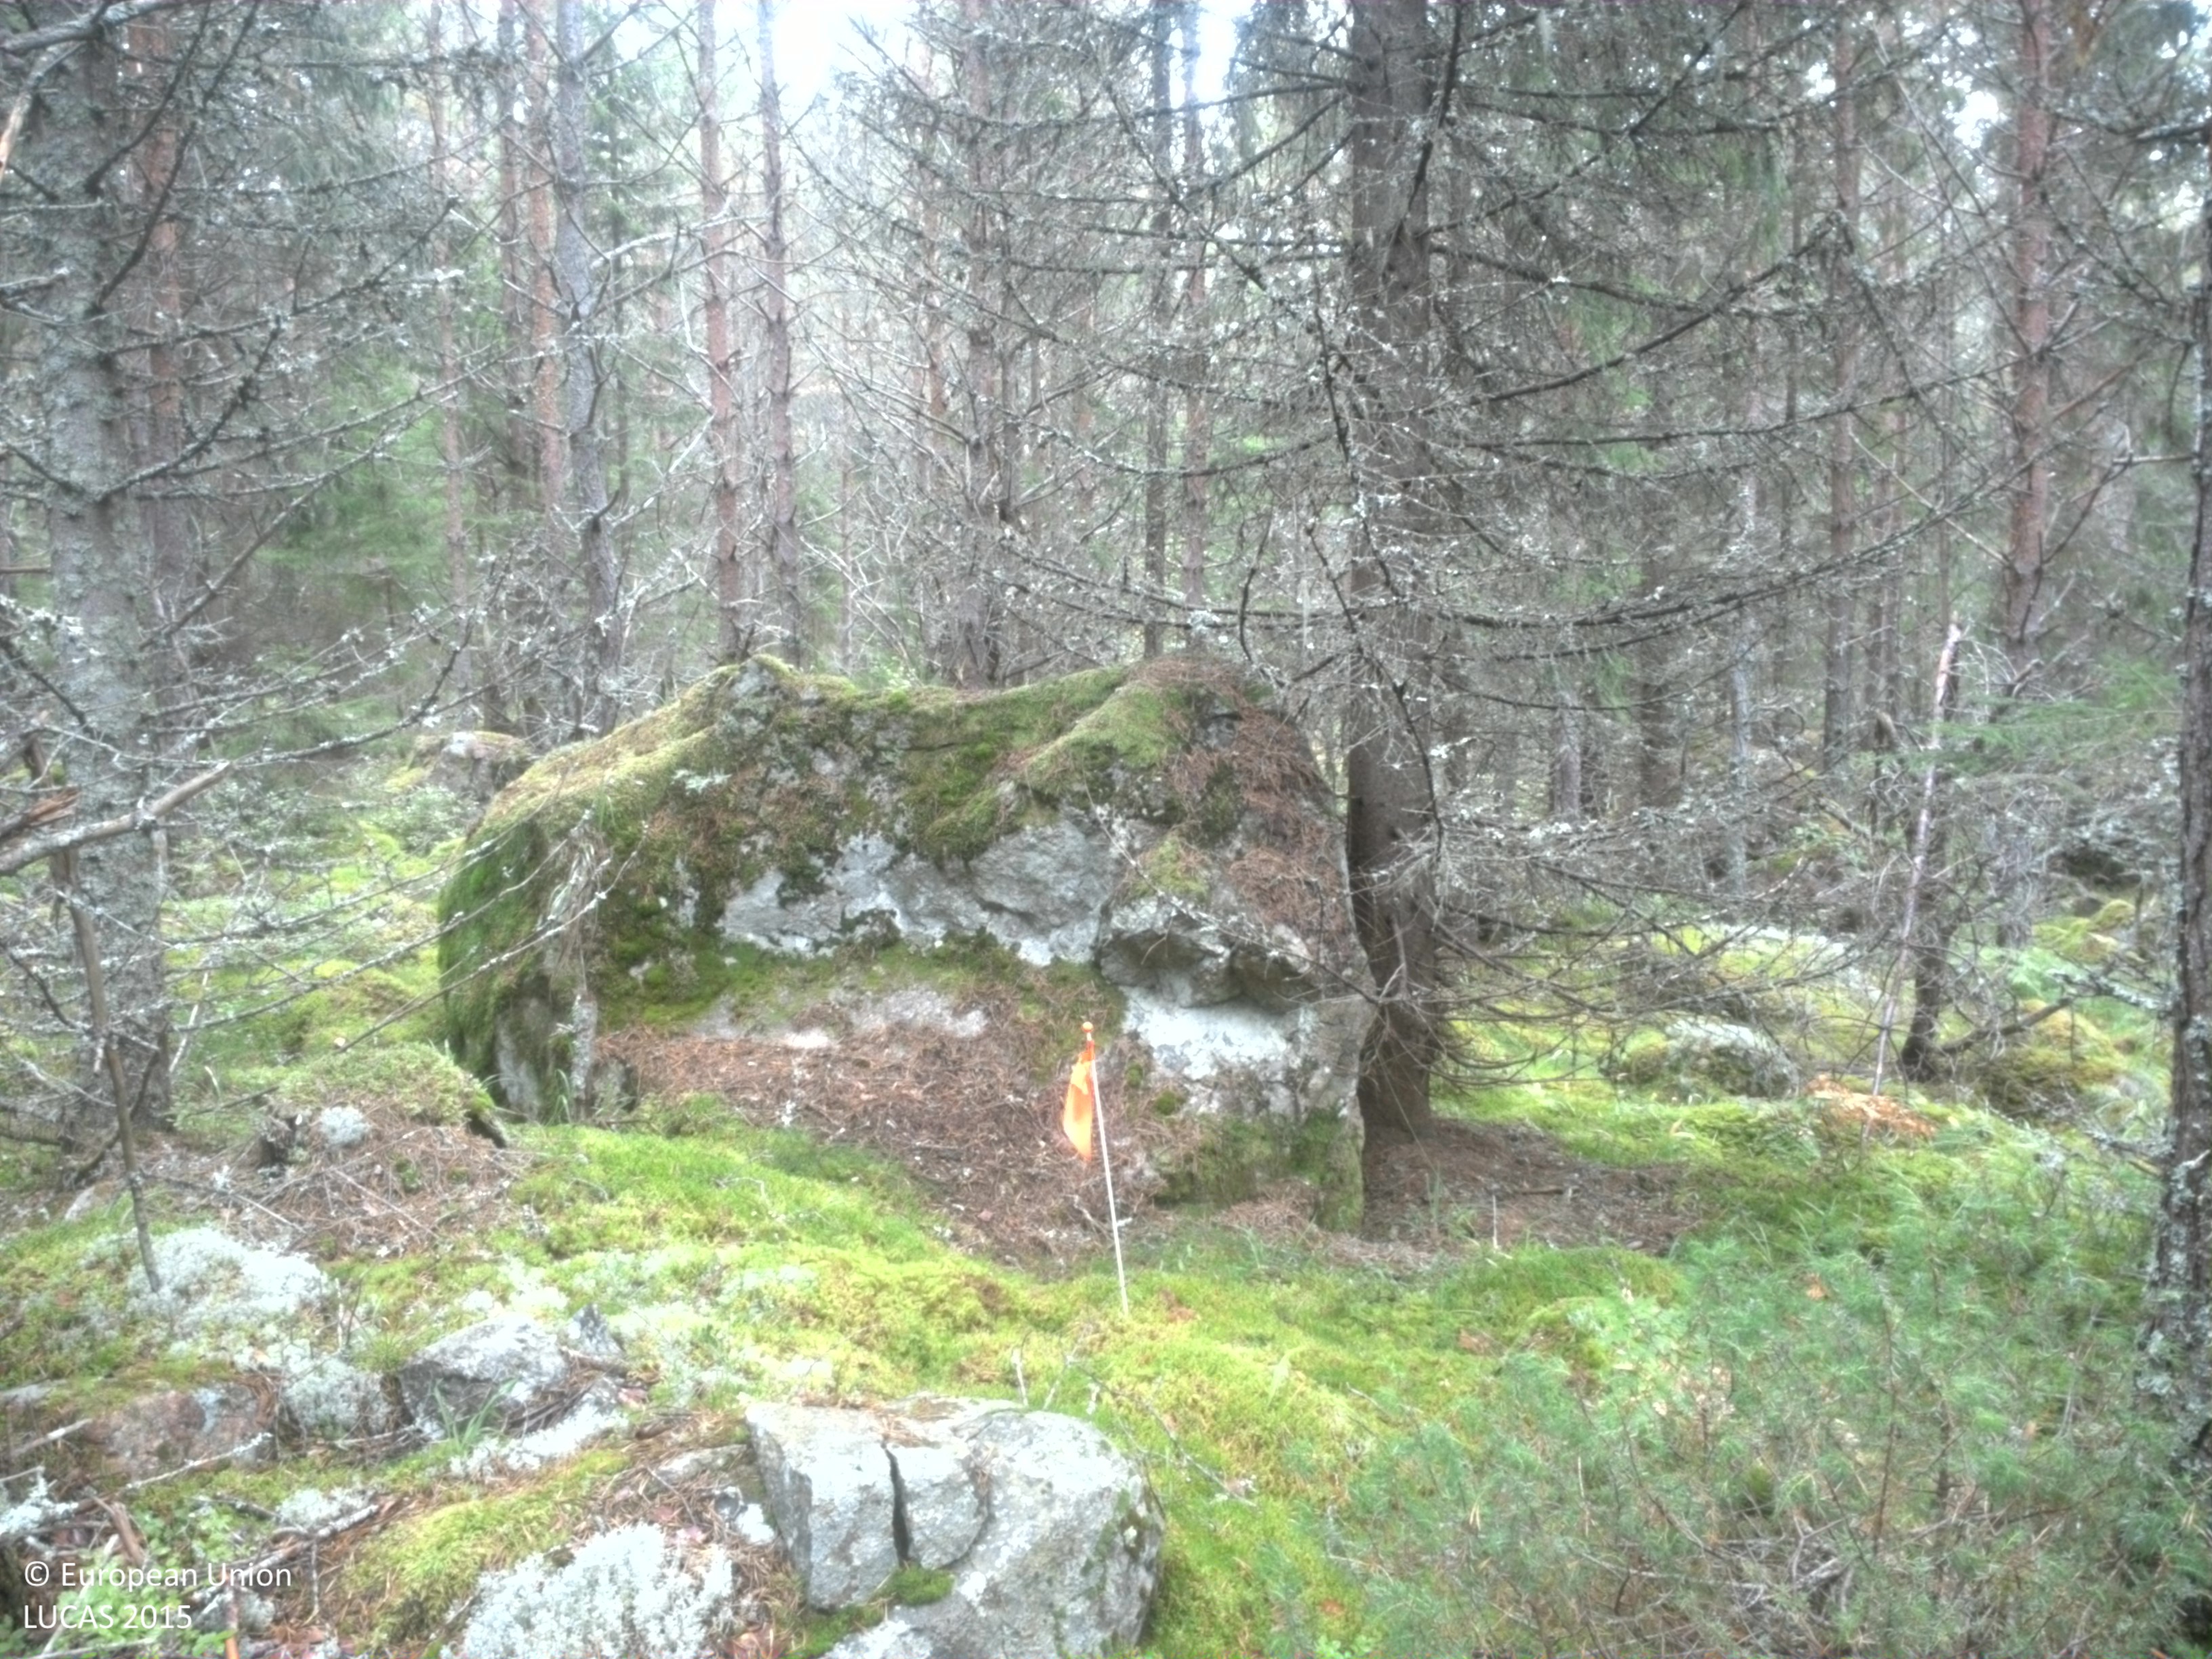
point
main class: Woodland
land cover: Other coniferous woodland
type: boreal forest
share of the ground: > 75 %
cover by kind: coniferous forest trees 75 %, lichens and mosses 15 %, shrubs 10 %
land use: Forestry
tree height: > 5 m
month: September
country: SE
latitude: 59.6523
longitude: 15.6512
